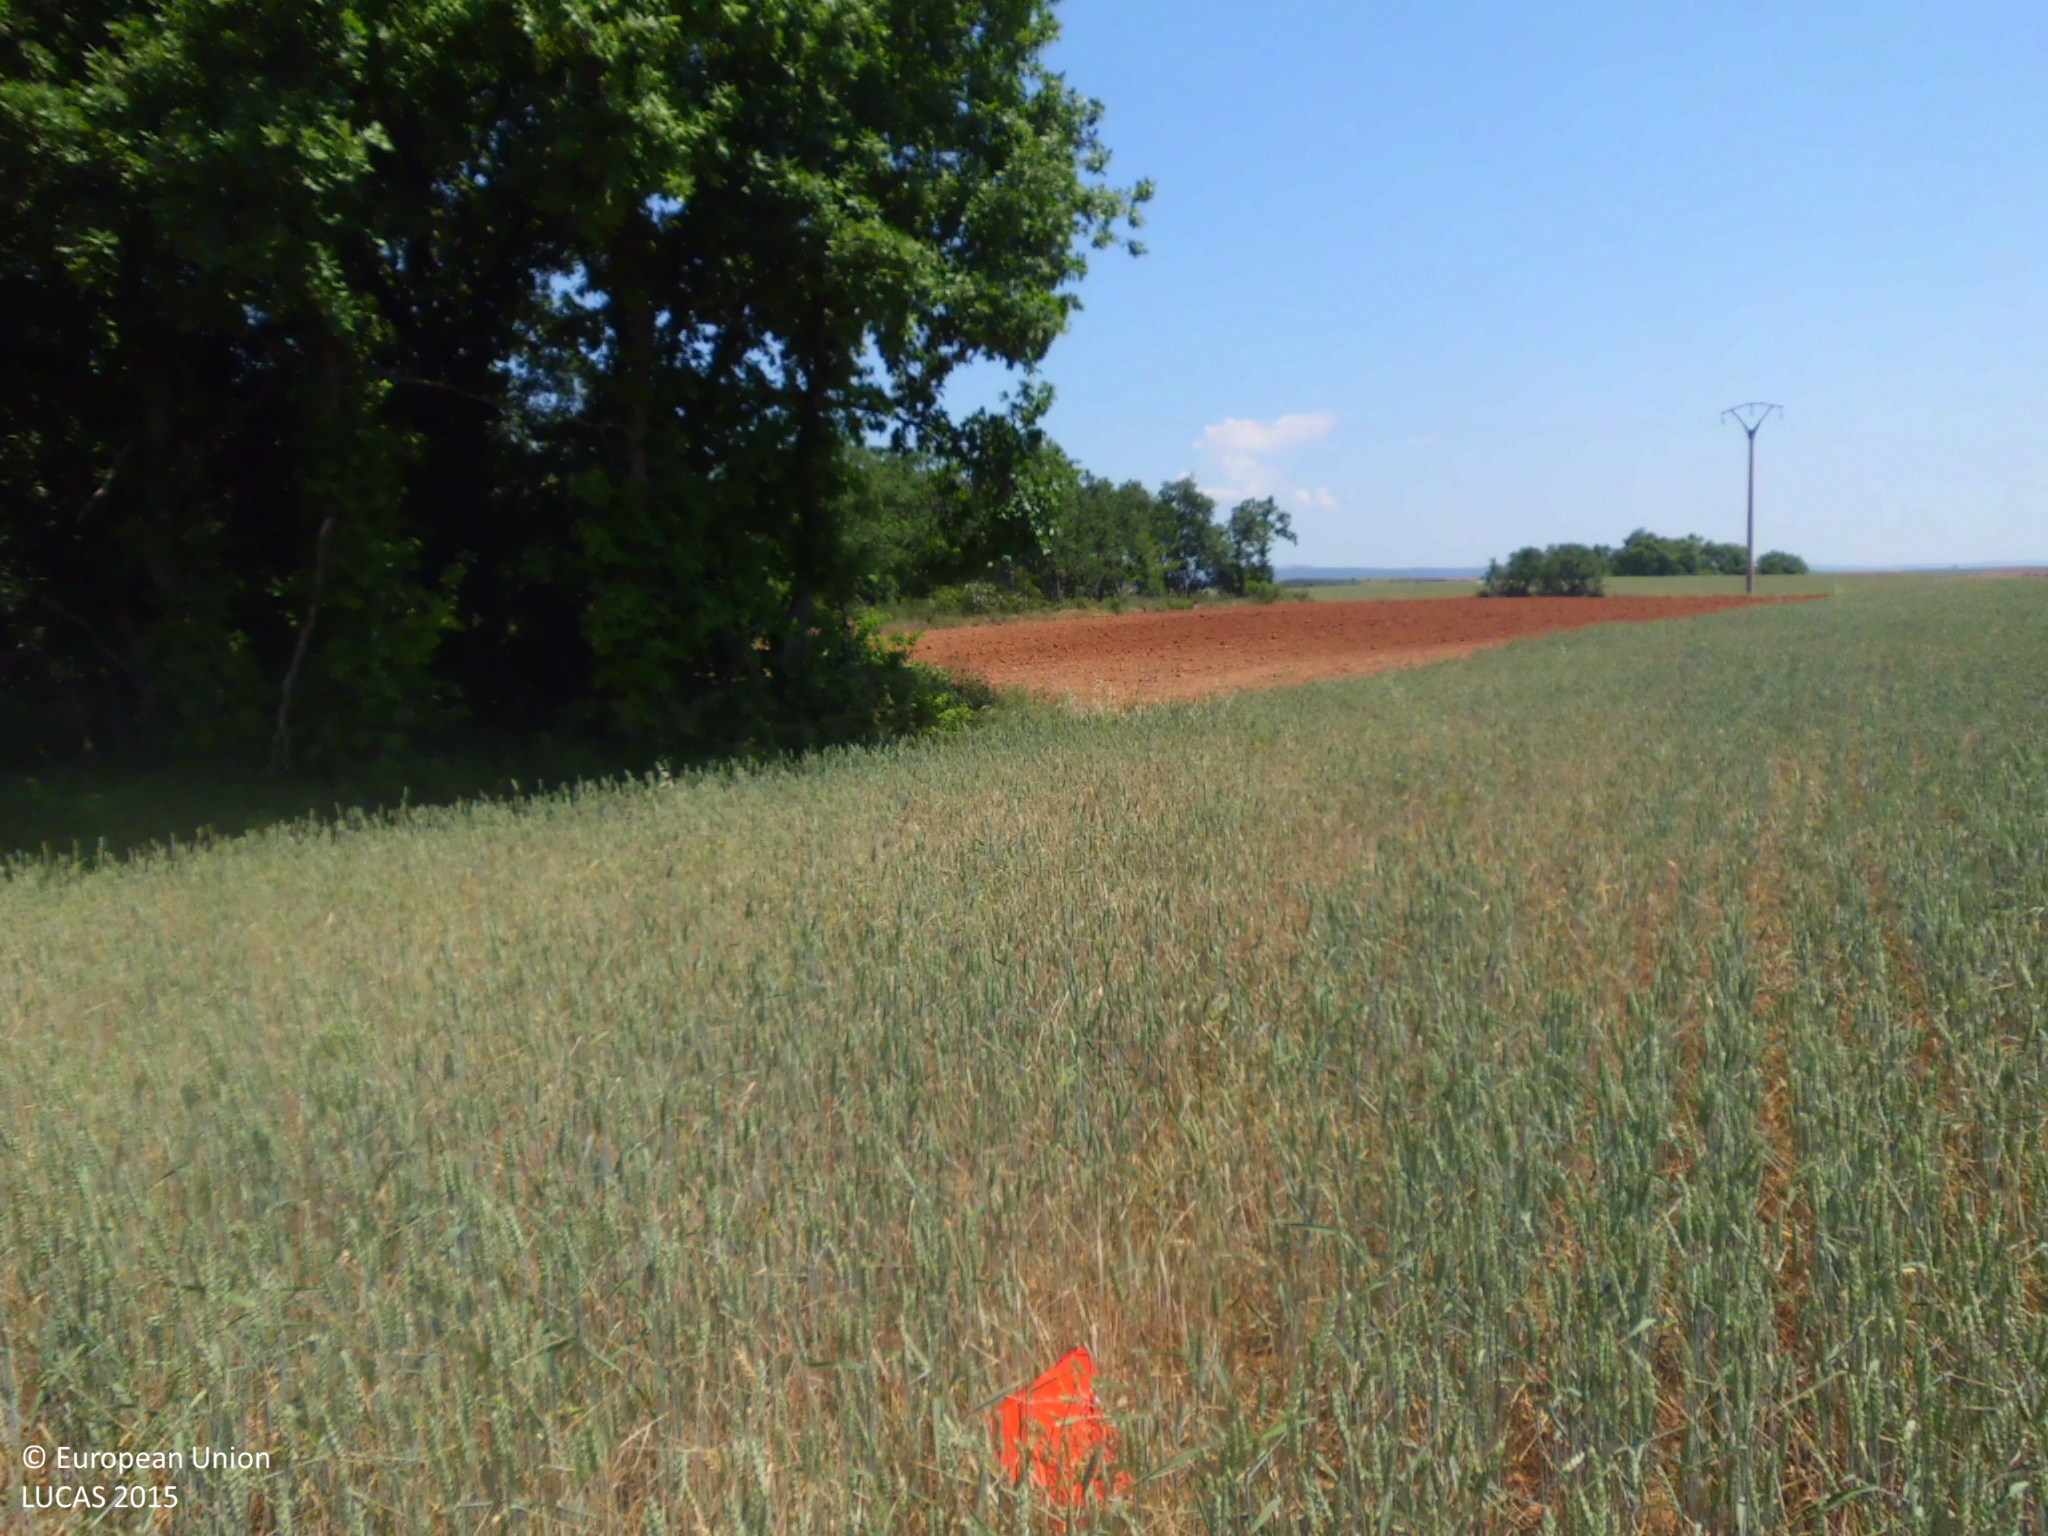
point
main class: Cropland
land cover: Common wheat
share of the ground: > 75 %
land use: Agriculture (excluding fallow land and kitchen gardens)
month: June
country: ES
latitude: 42.5933
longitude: -4.2451
